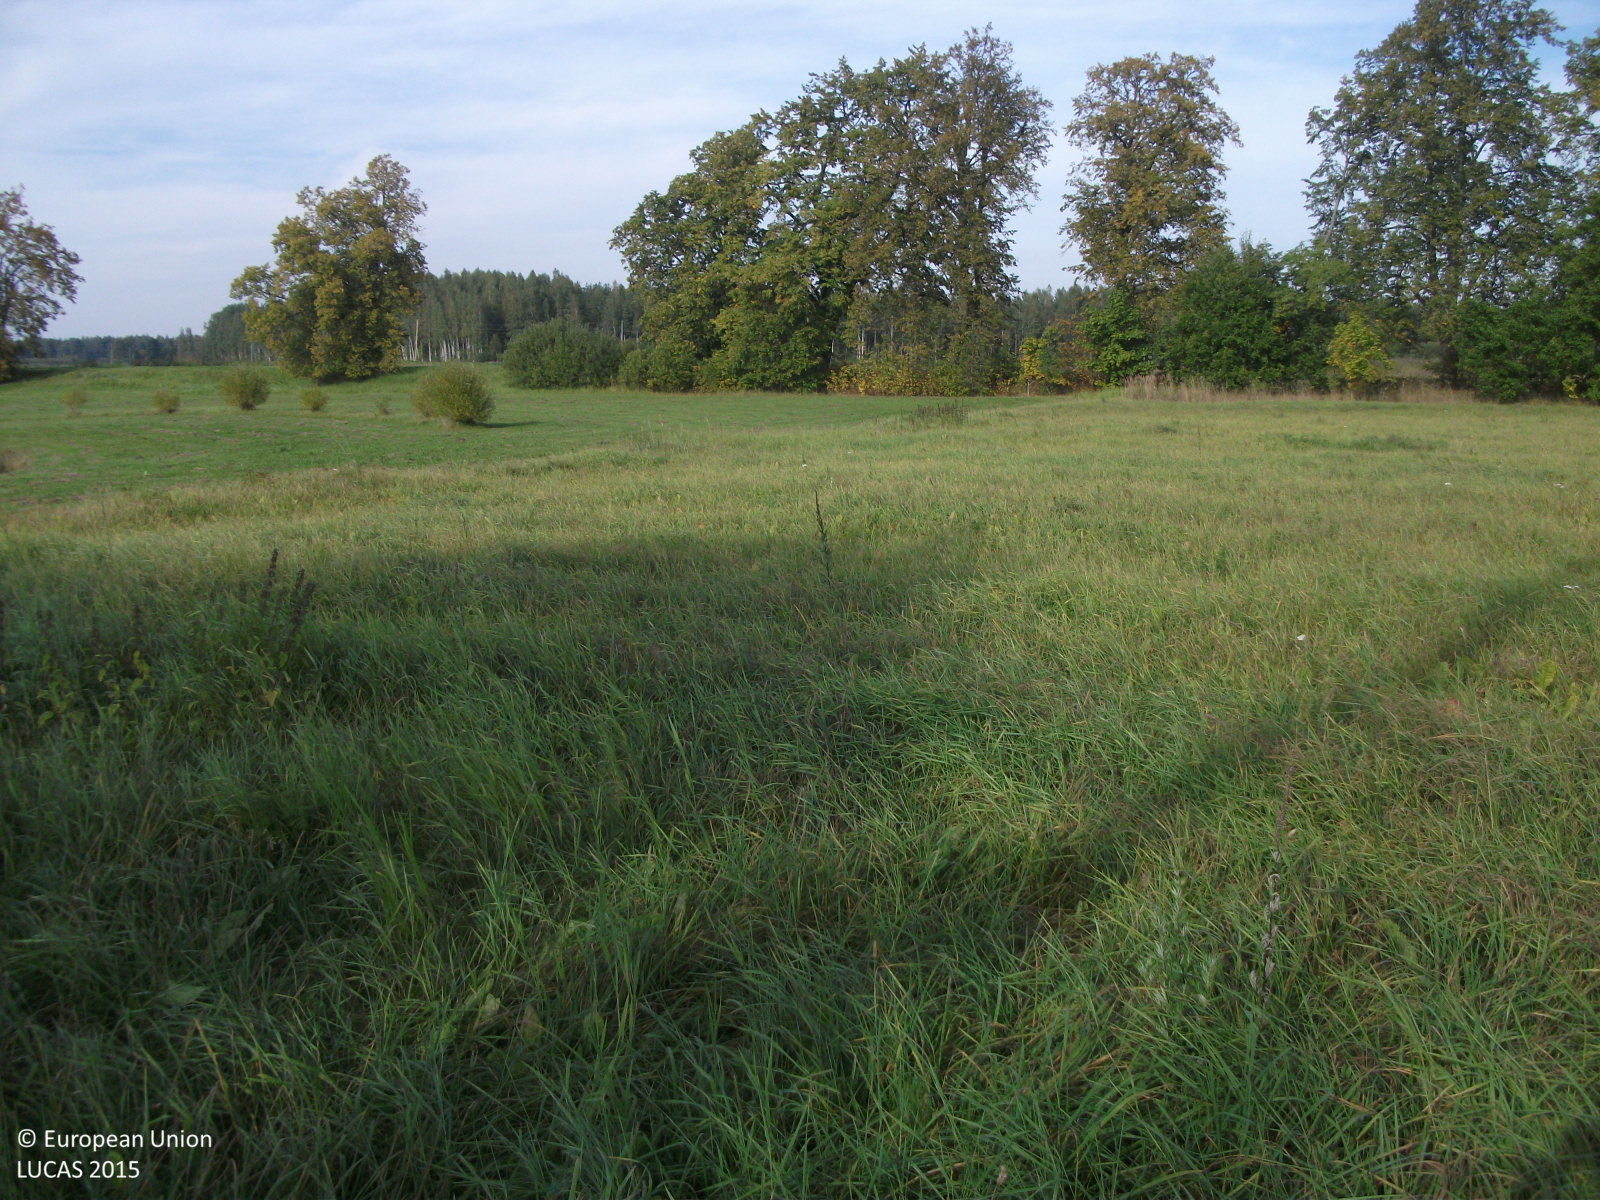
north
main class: Grassland
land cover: Grassland without tree/shrub cover
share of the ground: > 75 %
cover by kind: herbaceous plants 100 %
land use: Agriculture (excluding fallow land and kitchen gardens)
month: September
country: LV
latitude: 57.7774
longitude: 24.8097
